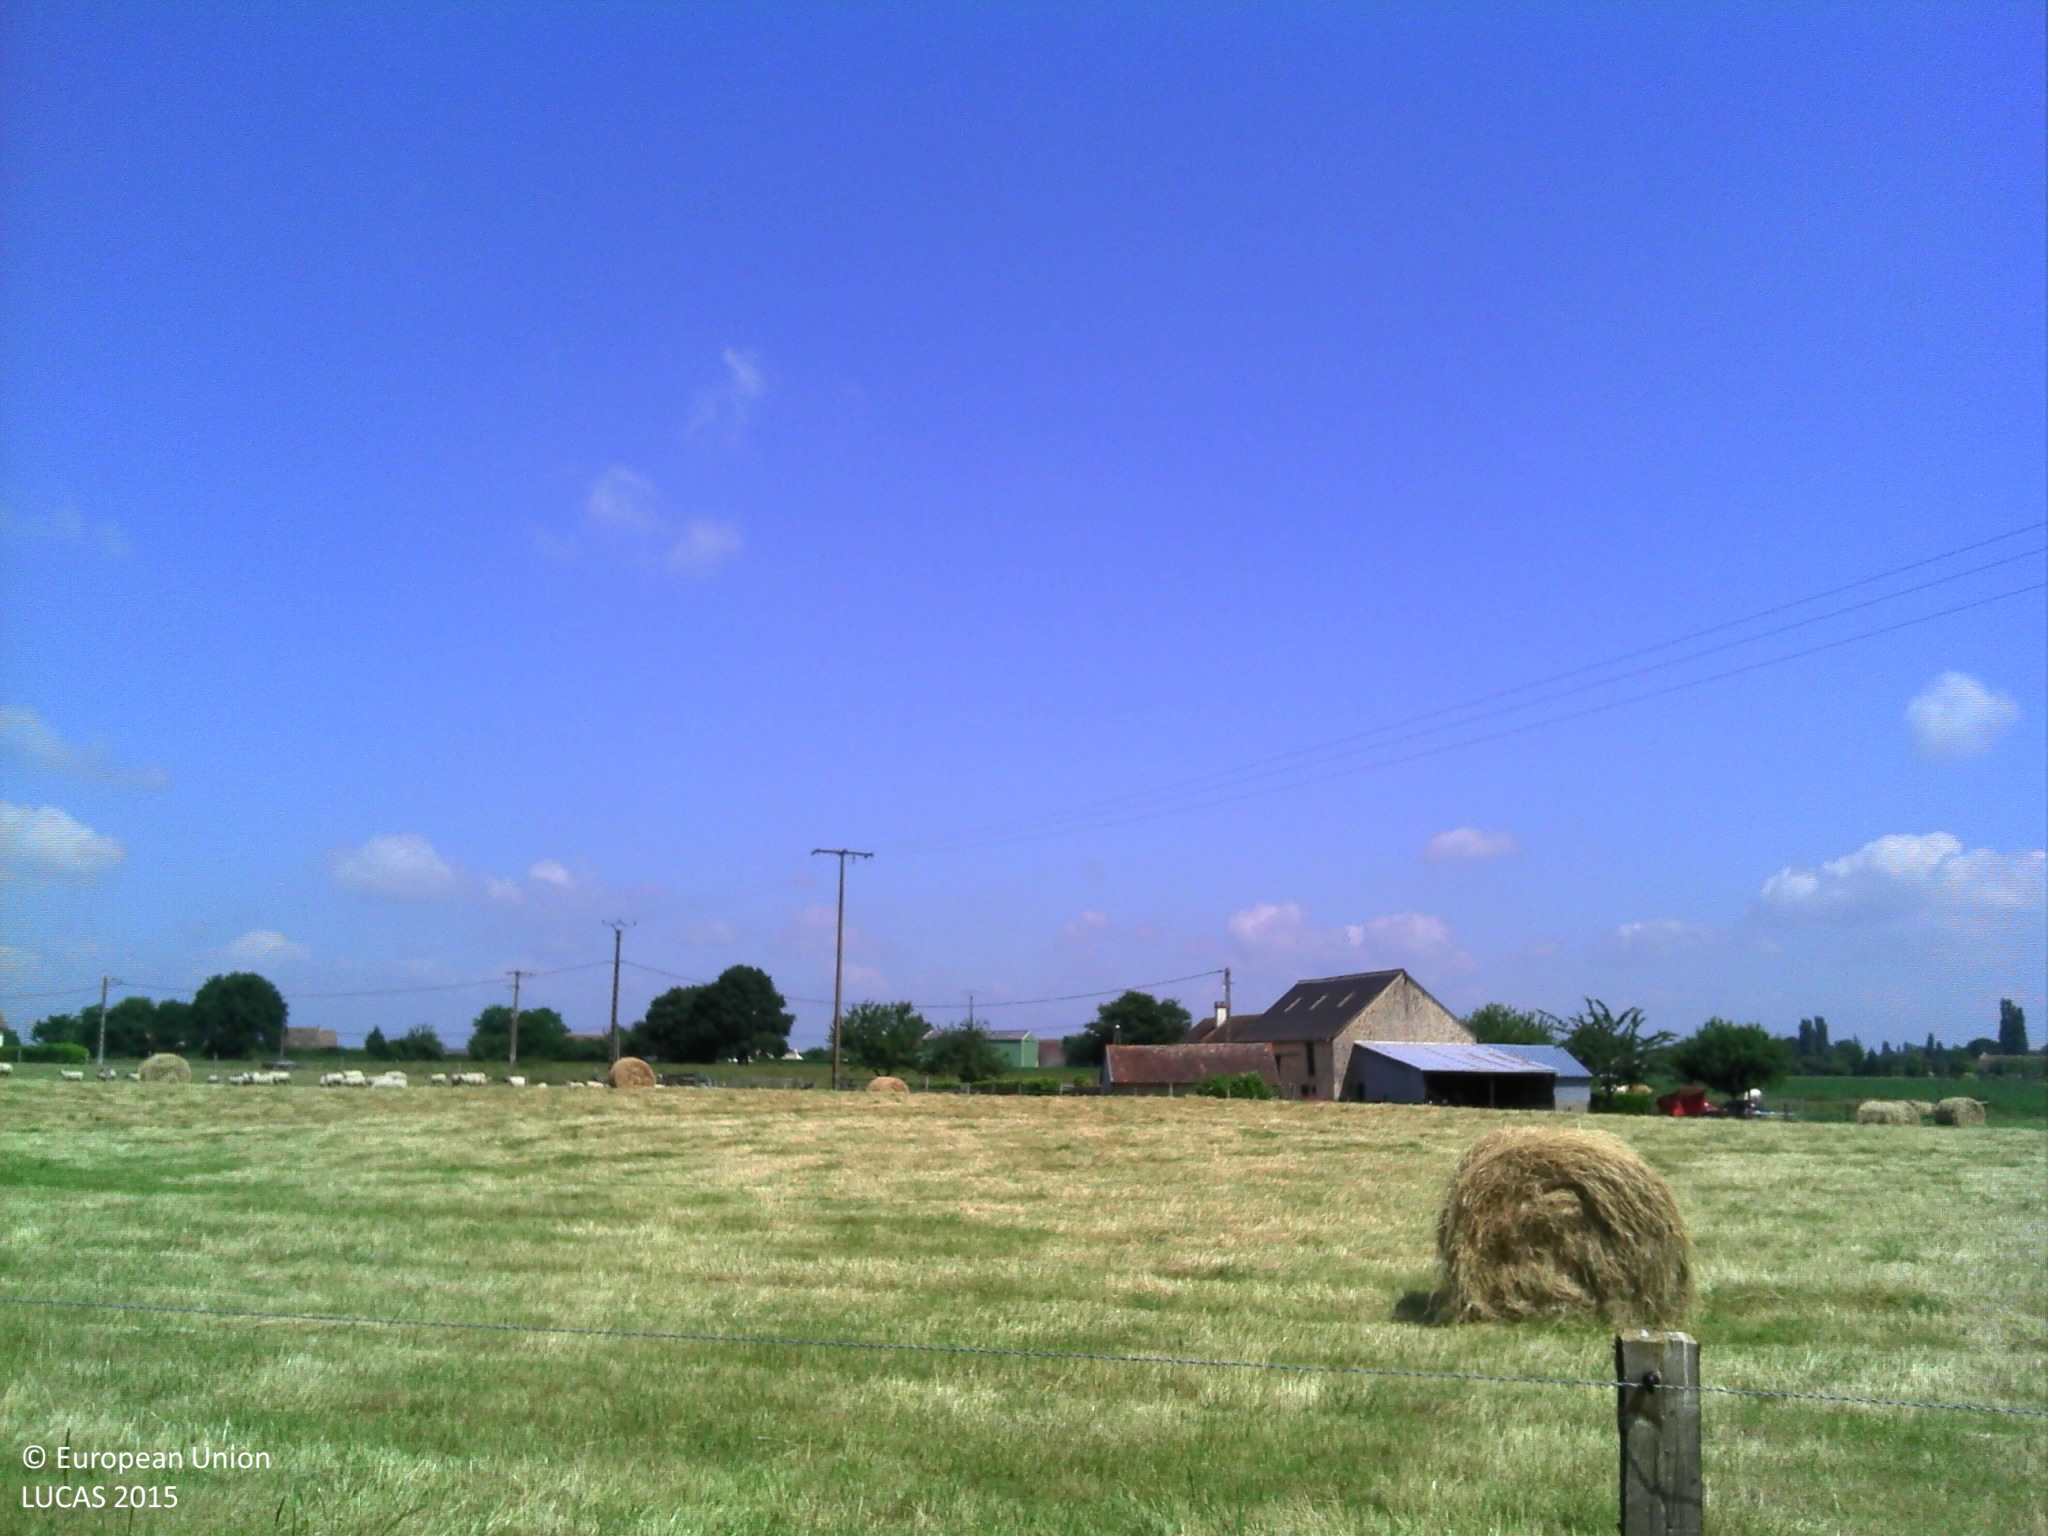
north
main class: Grassland
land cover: Grassland without tree/shrub cover
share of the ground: > 75 %
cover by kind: herbaceous plants 100 %
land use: Agriculture (excluding fallow land and kitchen gardens)
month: June
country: FR
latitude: 48.2448
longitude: 0.2646
